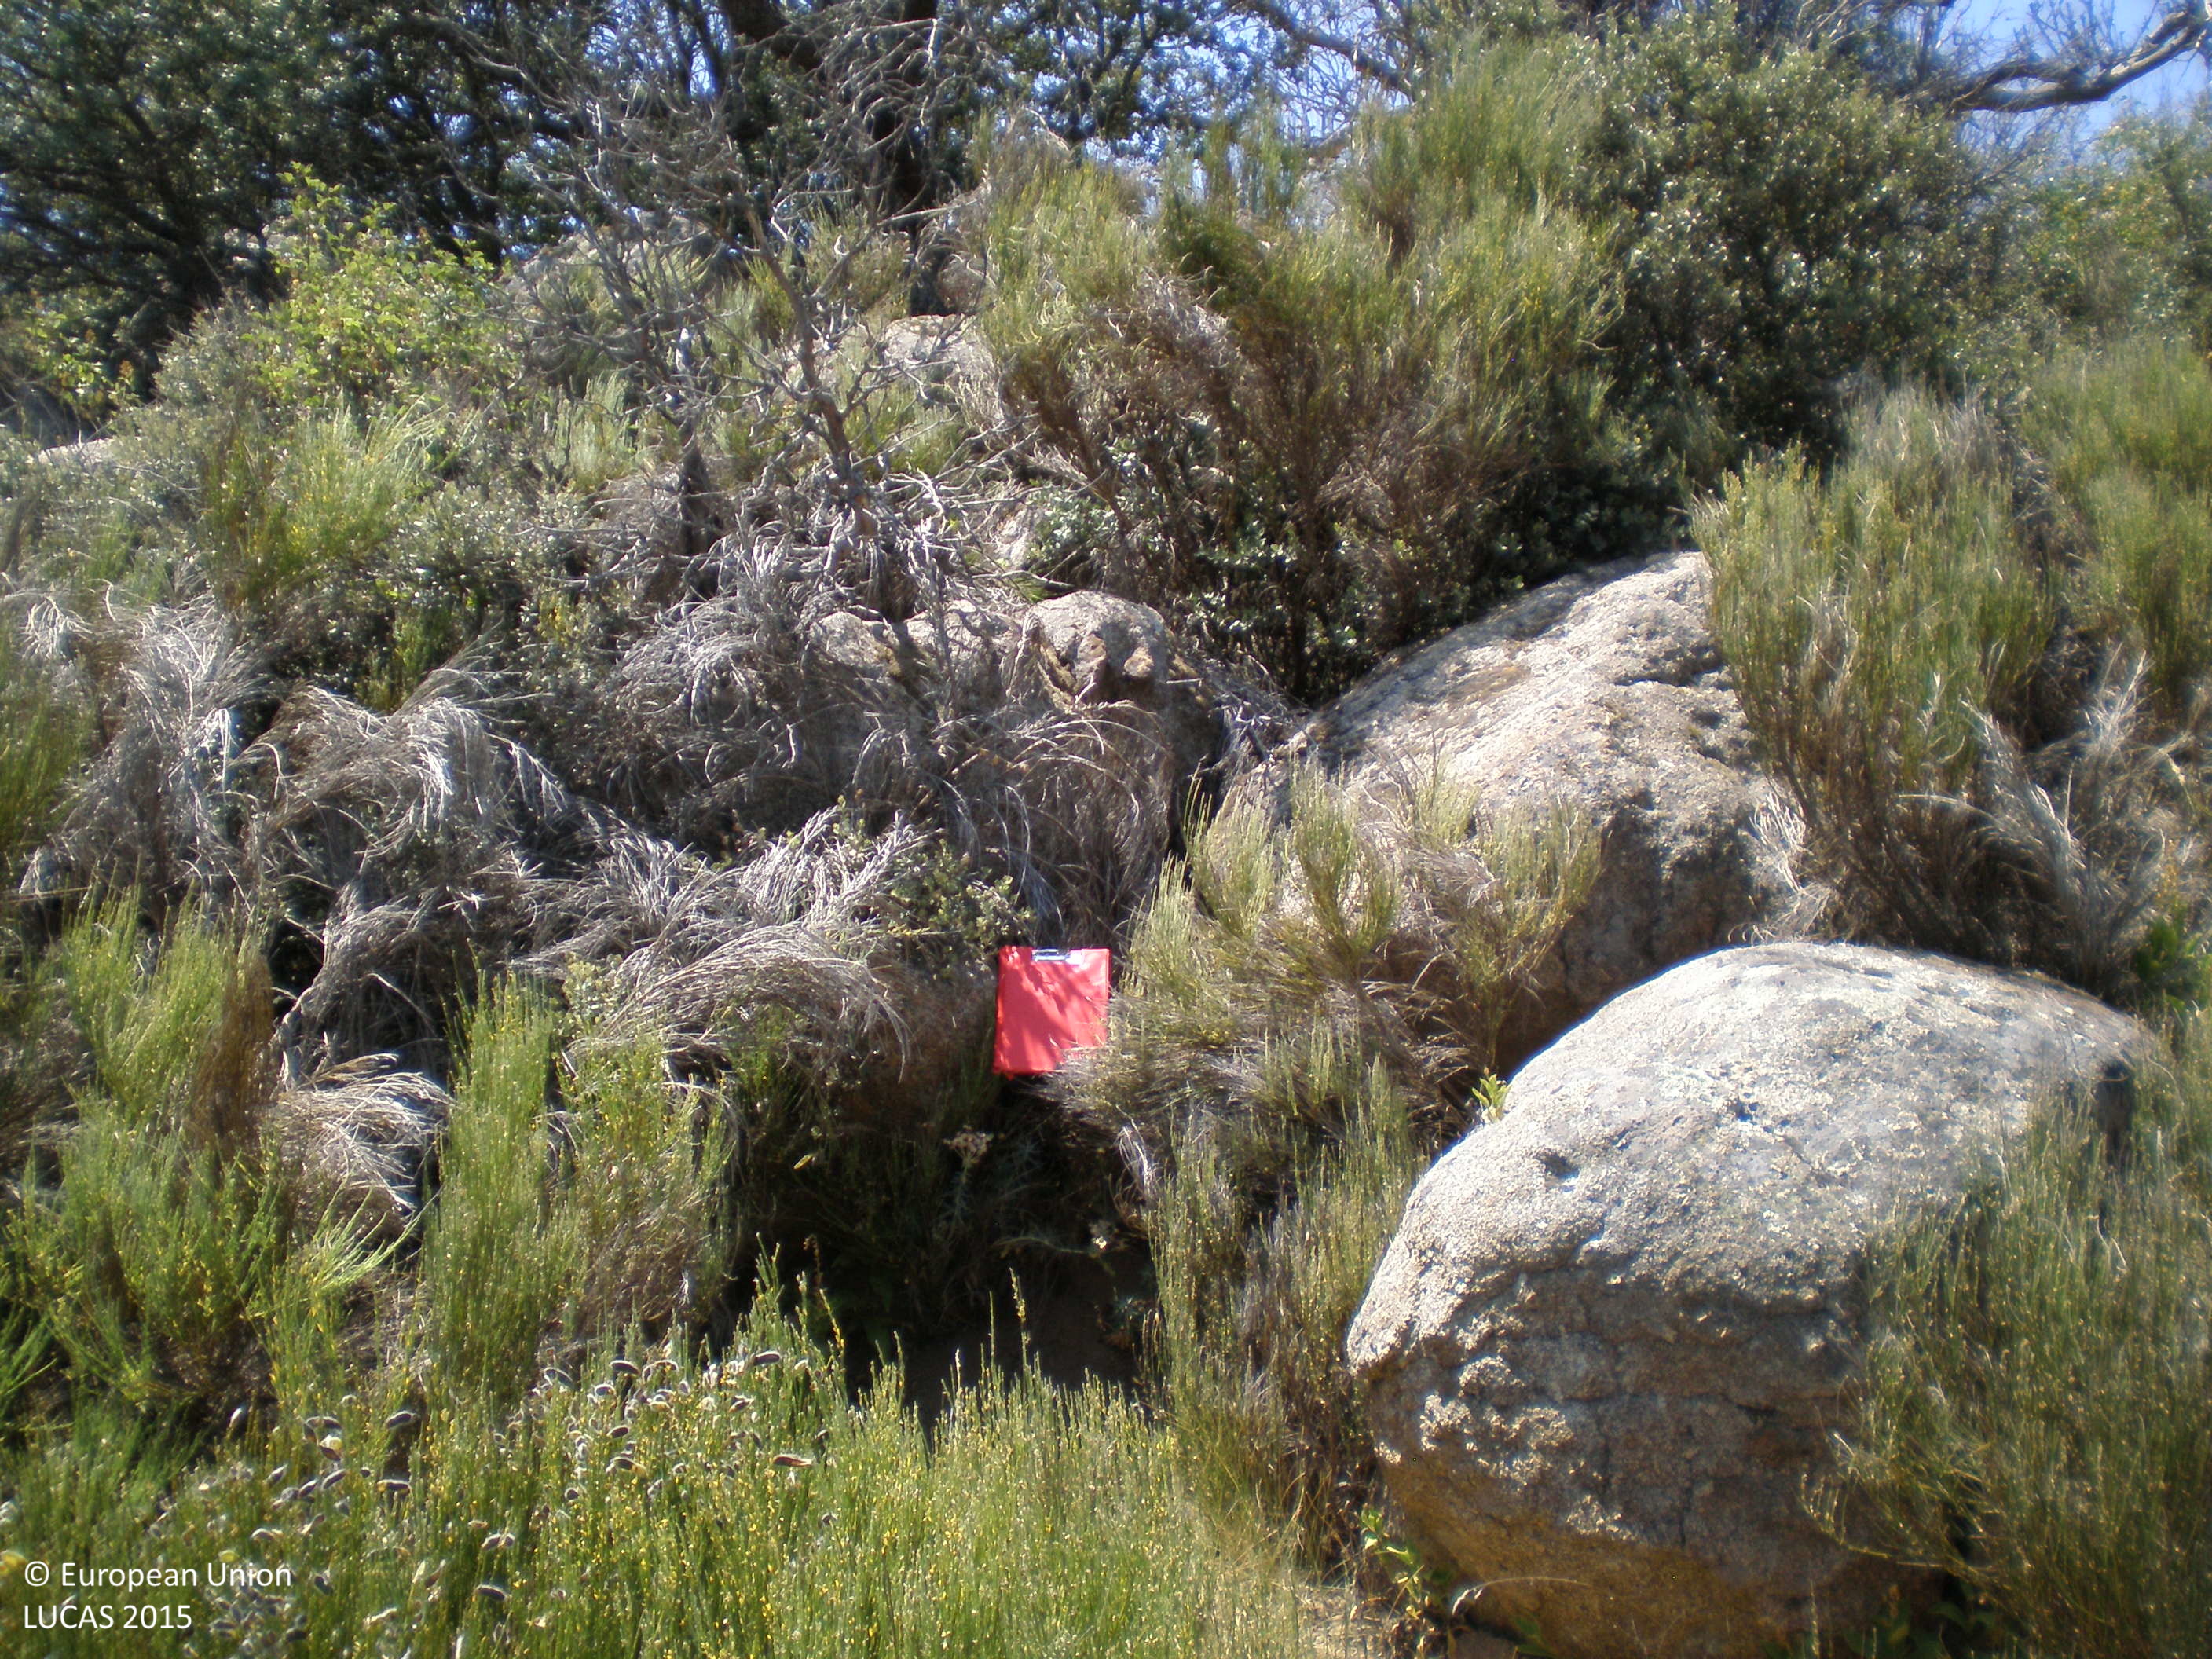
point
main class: Shrubland
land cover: Shrubland with sparse tree cover
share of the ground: 50 - 75 %
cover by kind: shrubs 60 %, herbaceous plants 20 %, consolidated bare surface 15 %, broadleaved forest trees 5 %
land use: Agriculture (excluding fallow land and kitchen gardens)
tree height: < 5 m
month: July
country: ES
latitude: 40.4277
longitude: -5.5916
